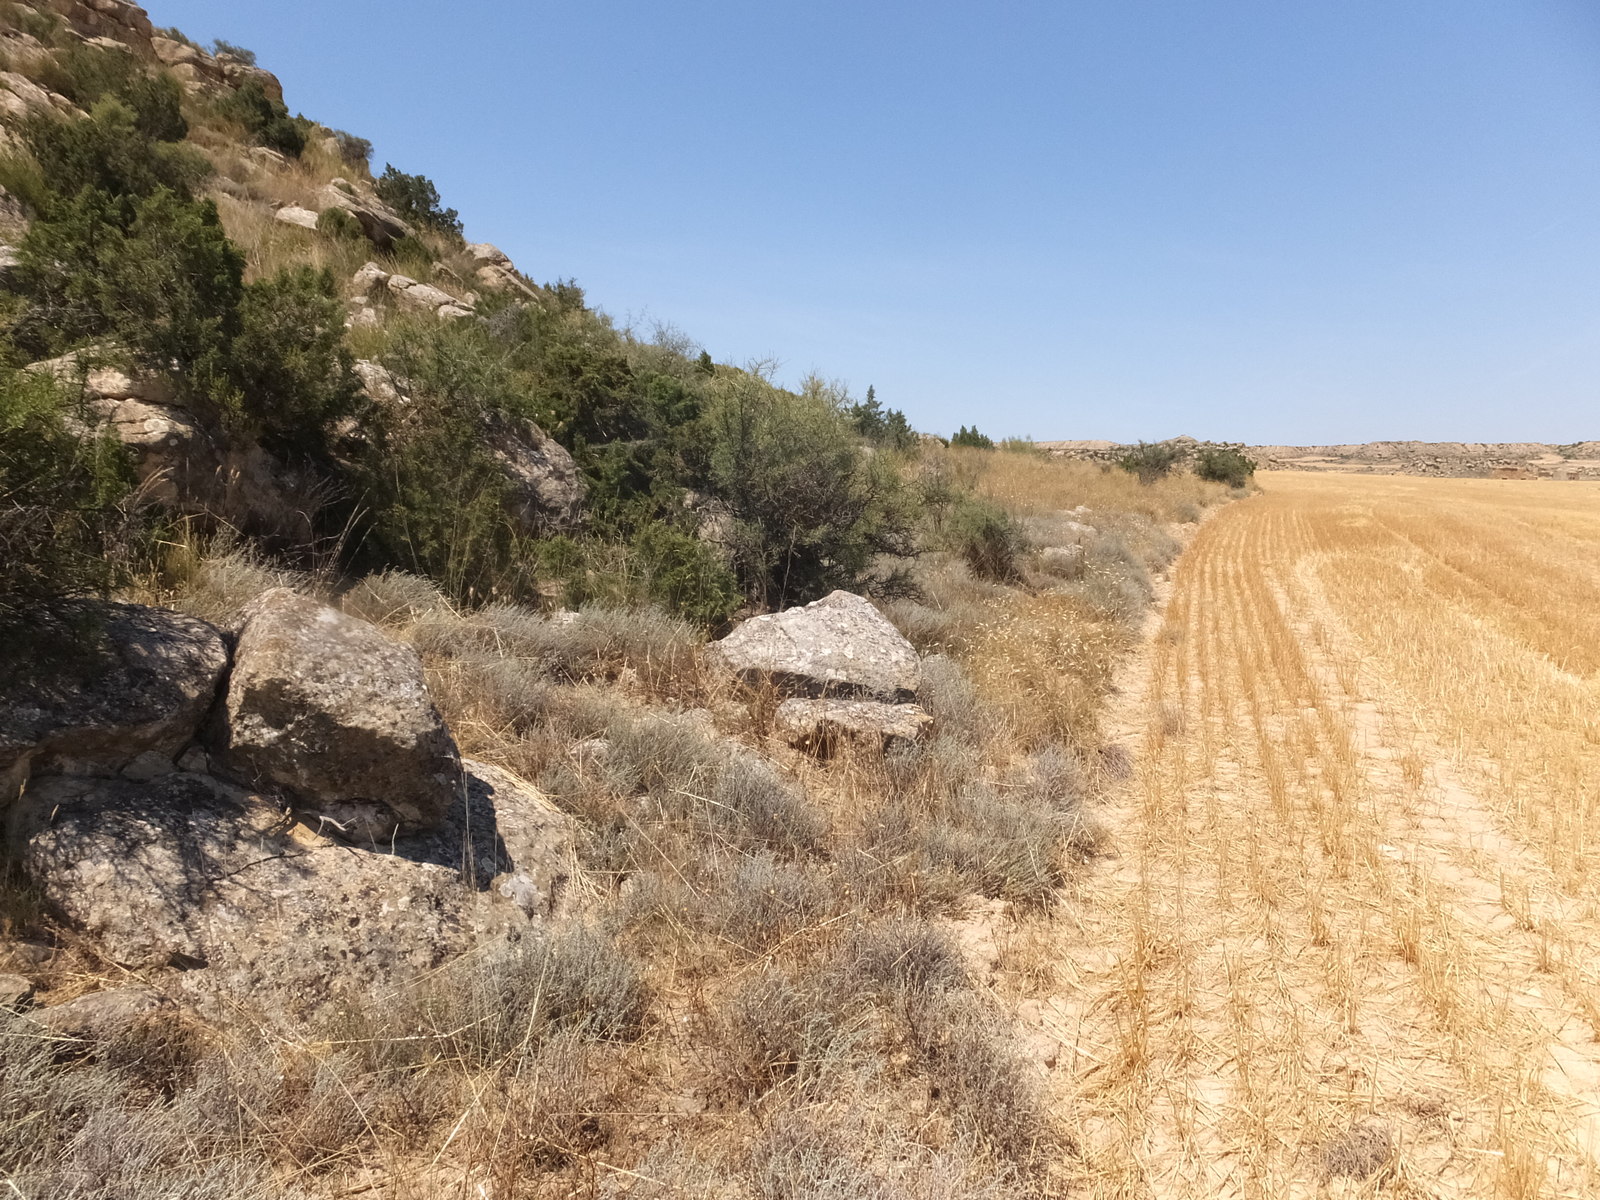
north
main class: Cropland
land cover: Barley
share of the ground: < 10 %
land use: Agriculture (excluding fallow land and kitchen gardens)
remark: Harvested field
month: June
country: ES
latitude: 41.2900
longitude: -0.1275
